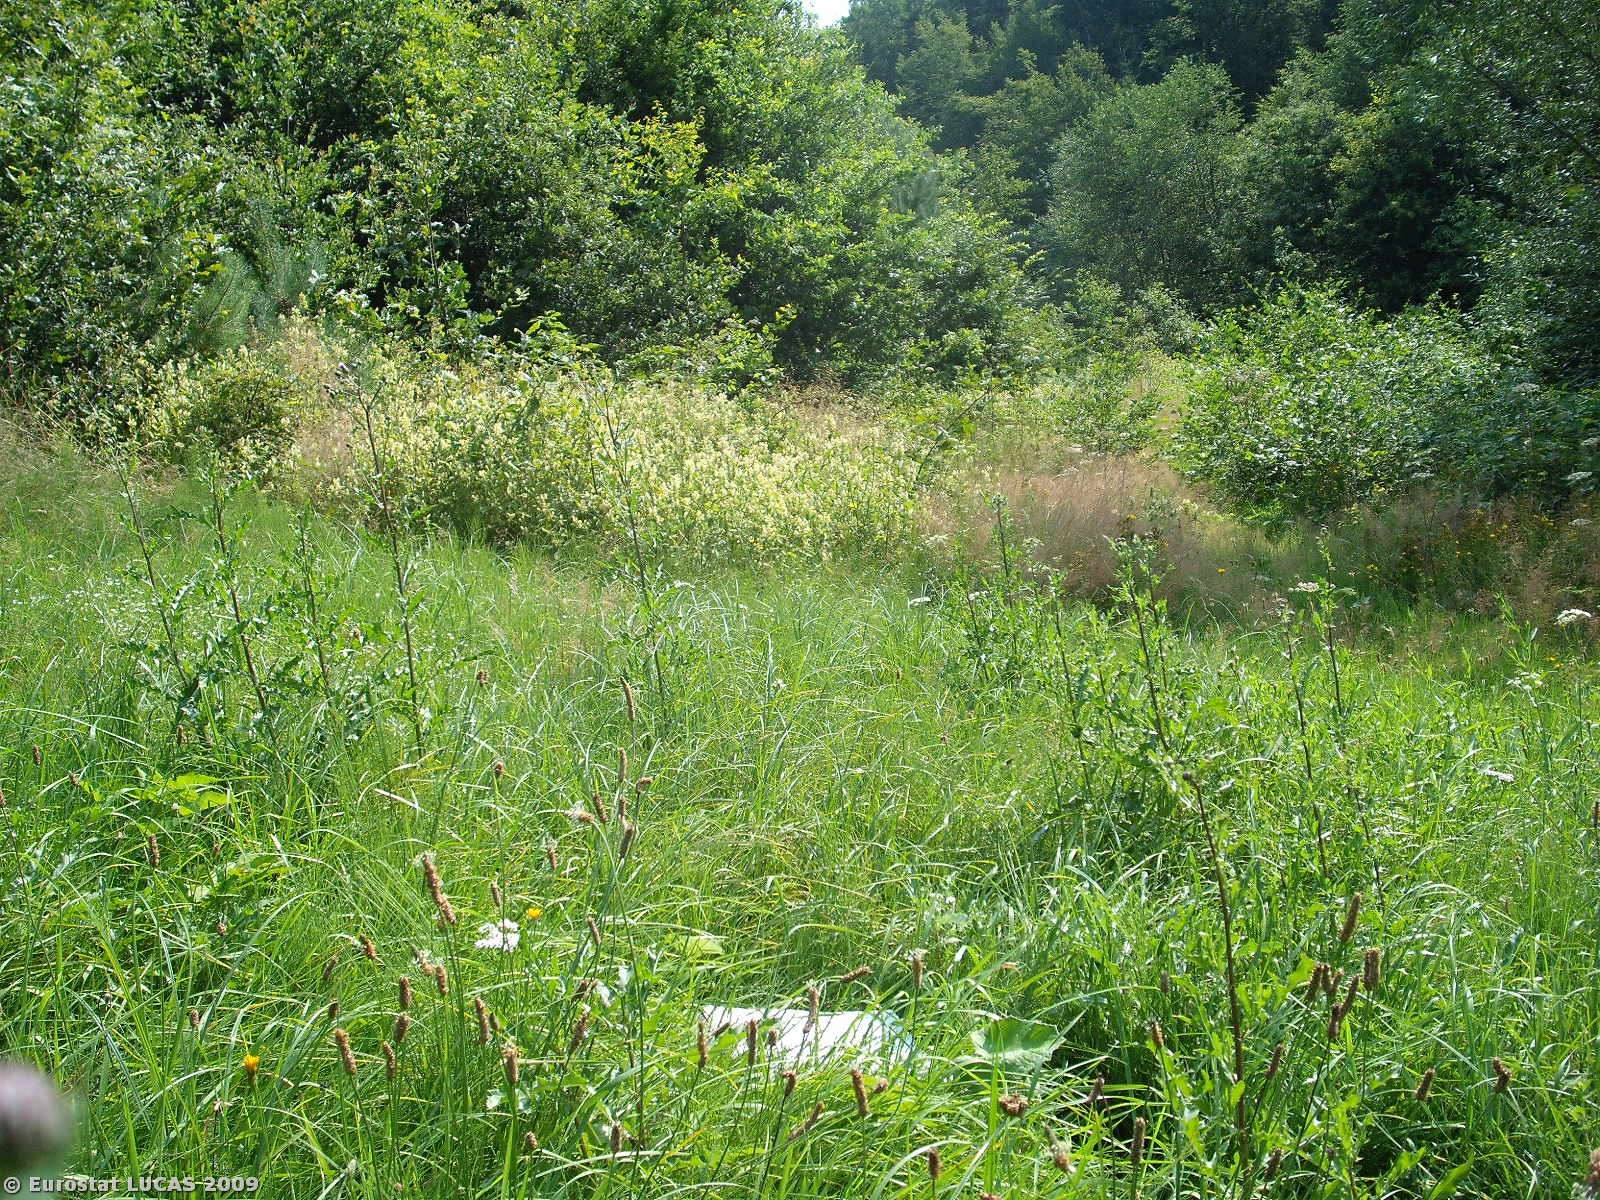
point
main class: Grassland
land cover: Grassland without tree/shrub cover
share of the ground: > 75 %
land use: Agriculture (excluding fallow land and kitchen gardens)
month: July
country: PL
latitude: 49.8278
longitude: 21.0399
